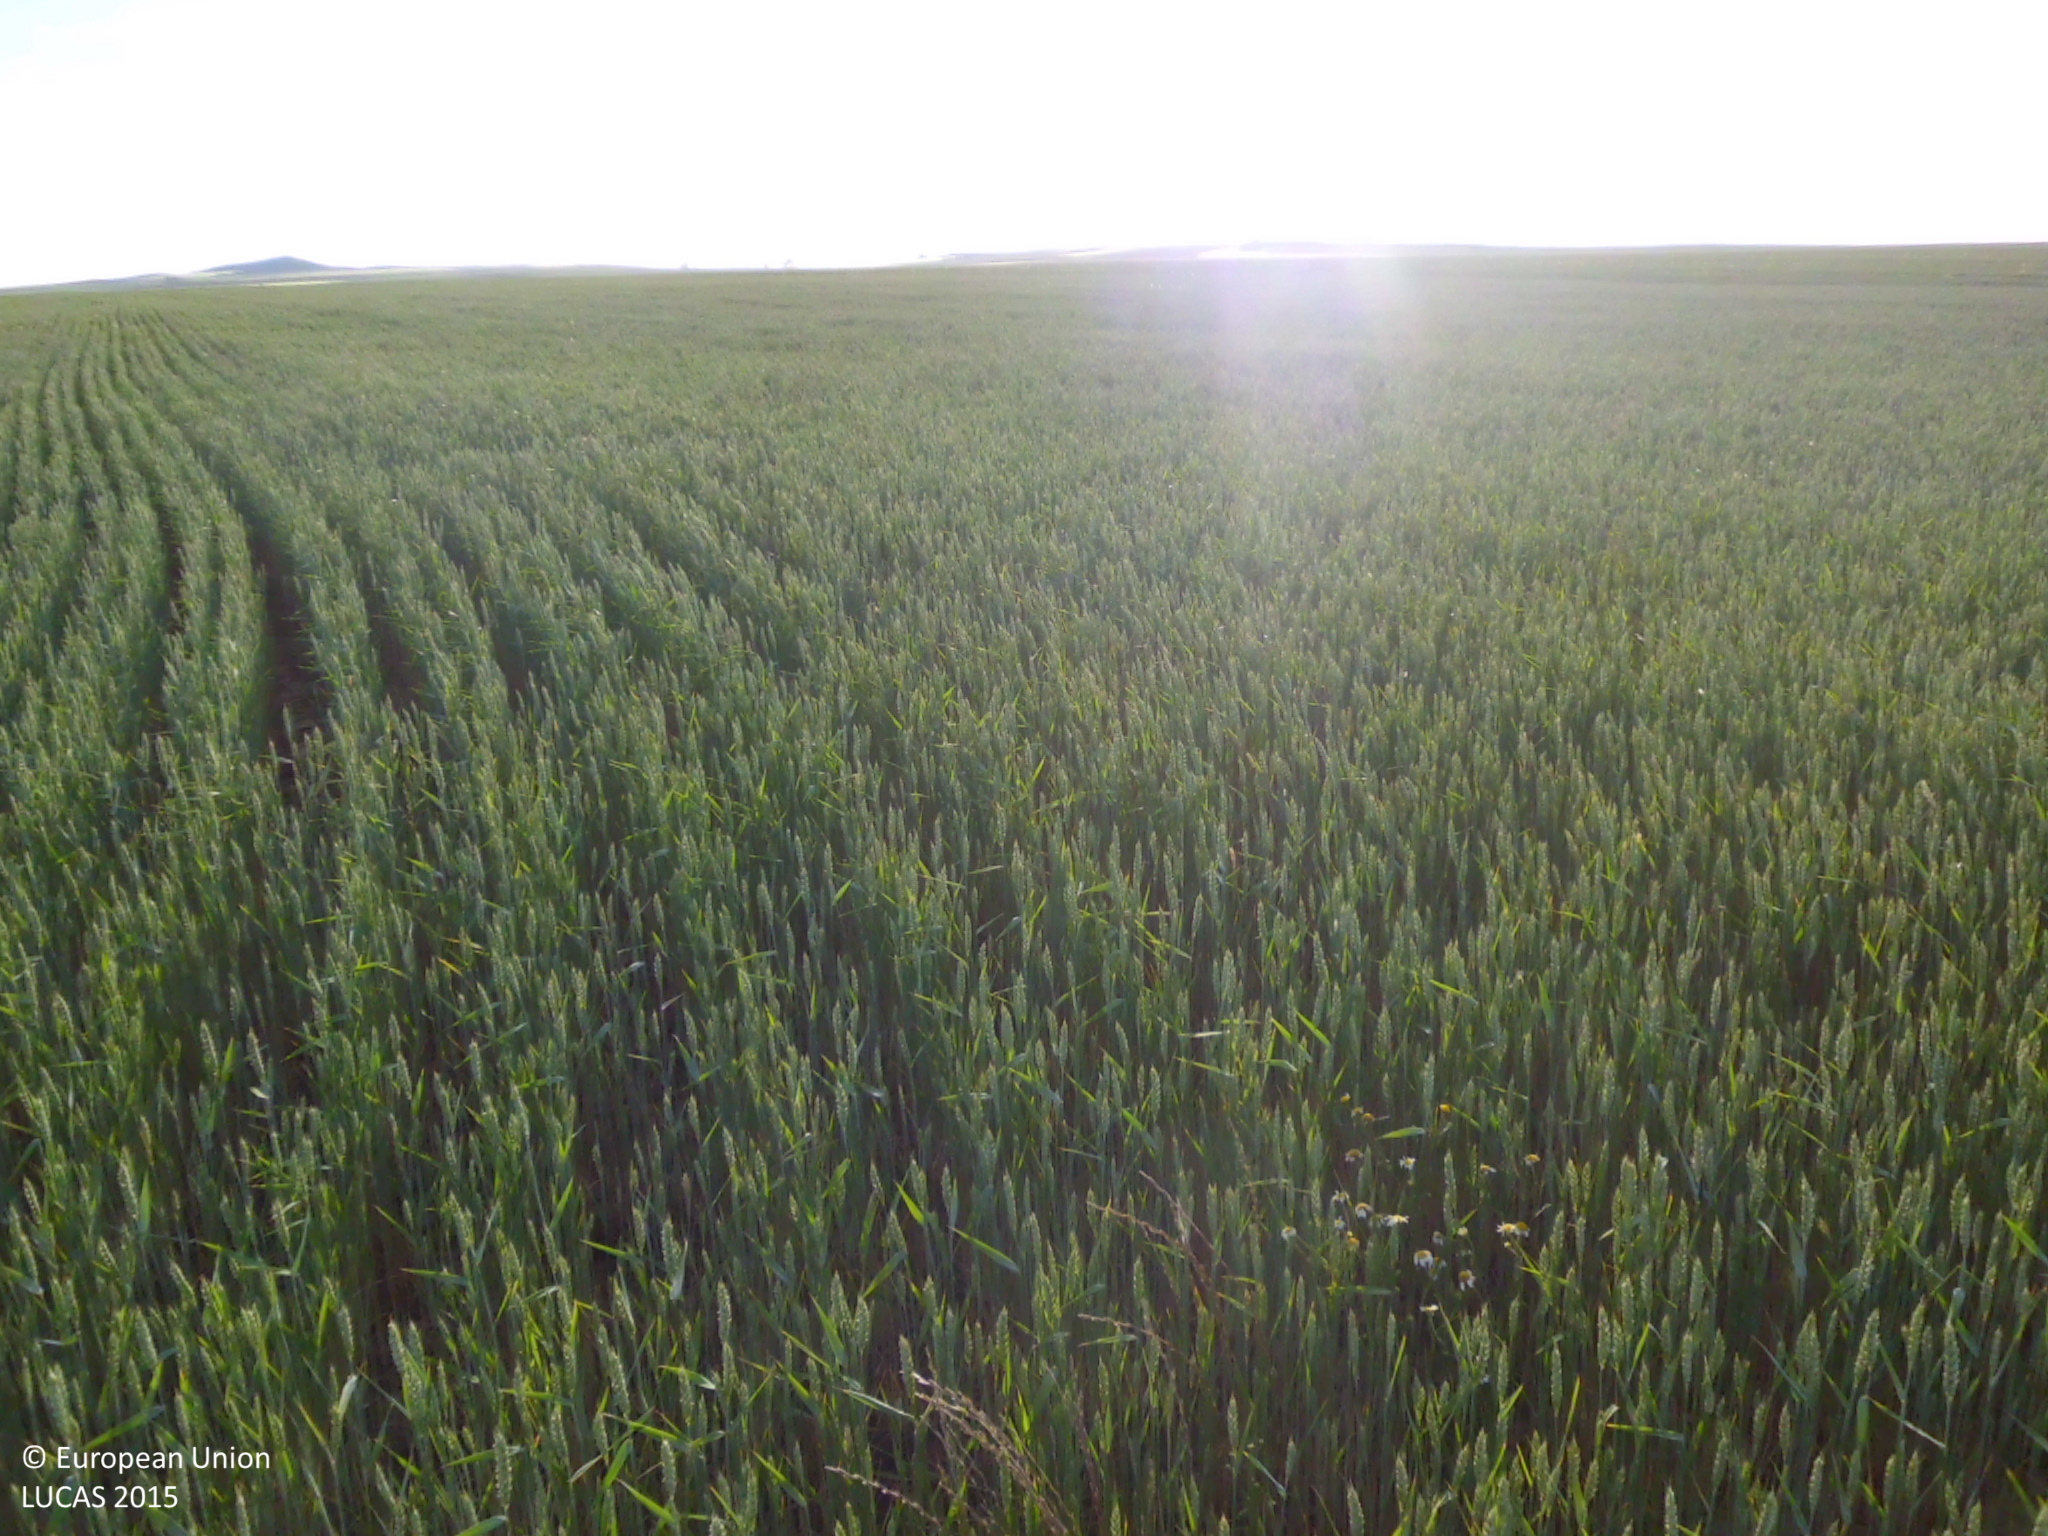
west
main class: Cropland
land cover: Common wheat
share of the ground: > 75 %
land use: Agriculture (excluding fallow land and kitchen gardens)
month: May
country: ES
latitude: 42.3455
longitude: -4.1856
